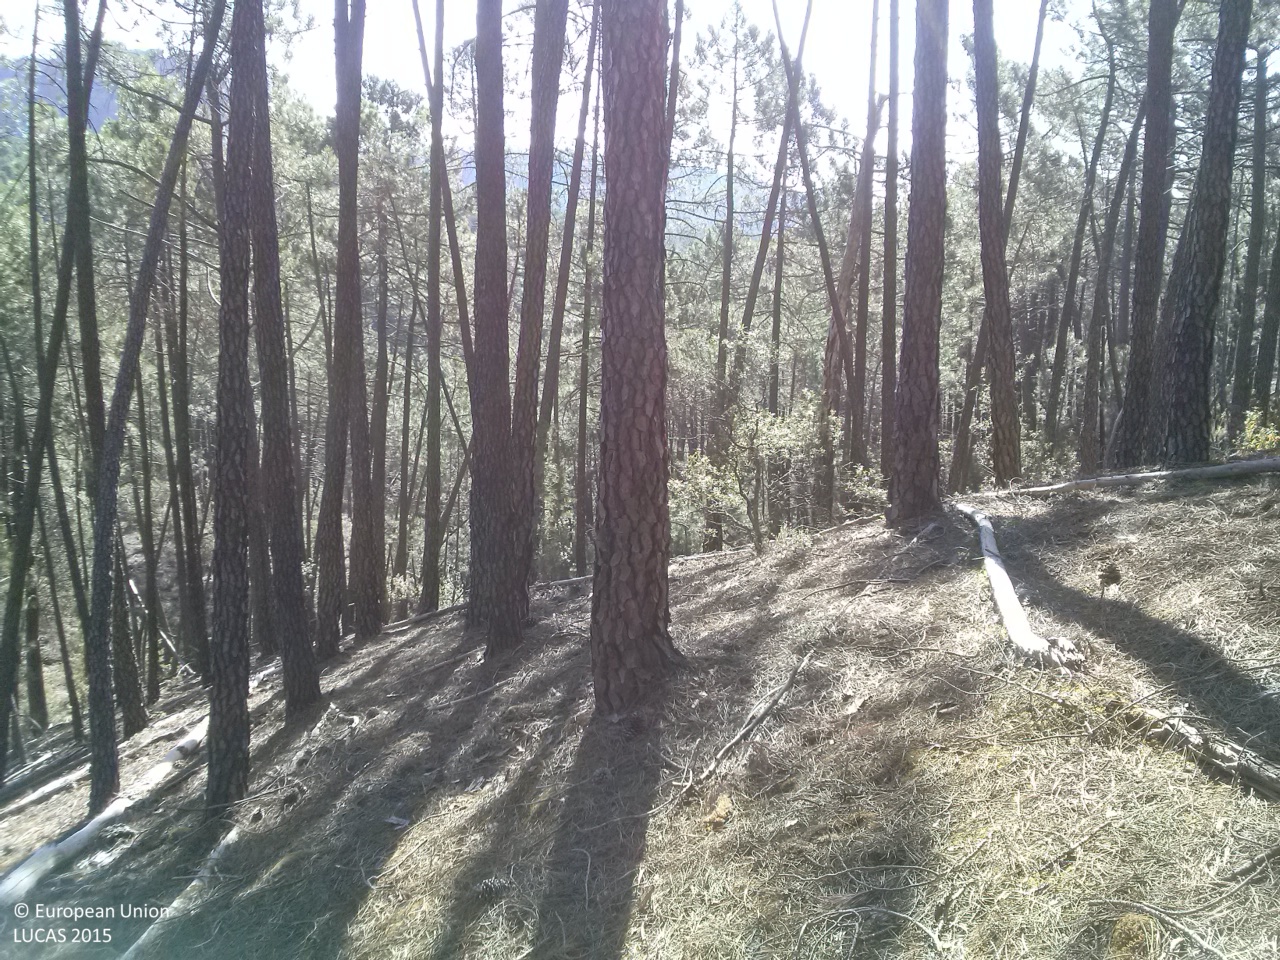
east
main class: Woodland
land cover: Pine dominated coniferous woodland
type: coniferous forest of the mediterranean region
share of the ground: > 75 %
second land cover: Shrubland without tree cover
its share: < 10 %
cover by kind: coniferous forest trees 85 %, shrubs 10 %, herbaceous plants 5 %
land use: Forestry
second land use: Agriculture (excluding fallow land and kitchen gardens)
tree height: > 5 m
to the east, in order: Pine dominated coniferous woodland; Shrubland without tree cover; Pine dominated coniferous woodland; Other structural elements; Pine dominated coniferous woodland
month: June
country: ES
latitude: 39.9891
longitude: -1.6637
